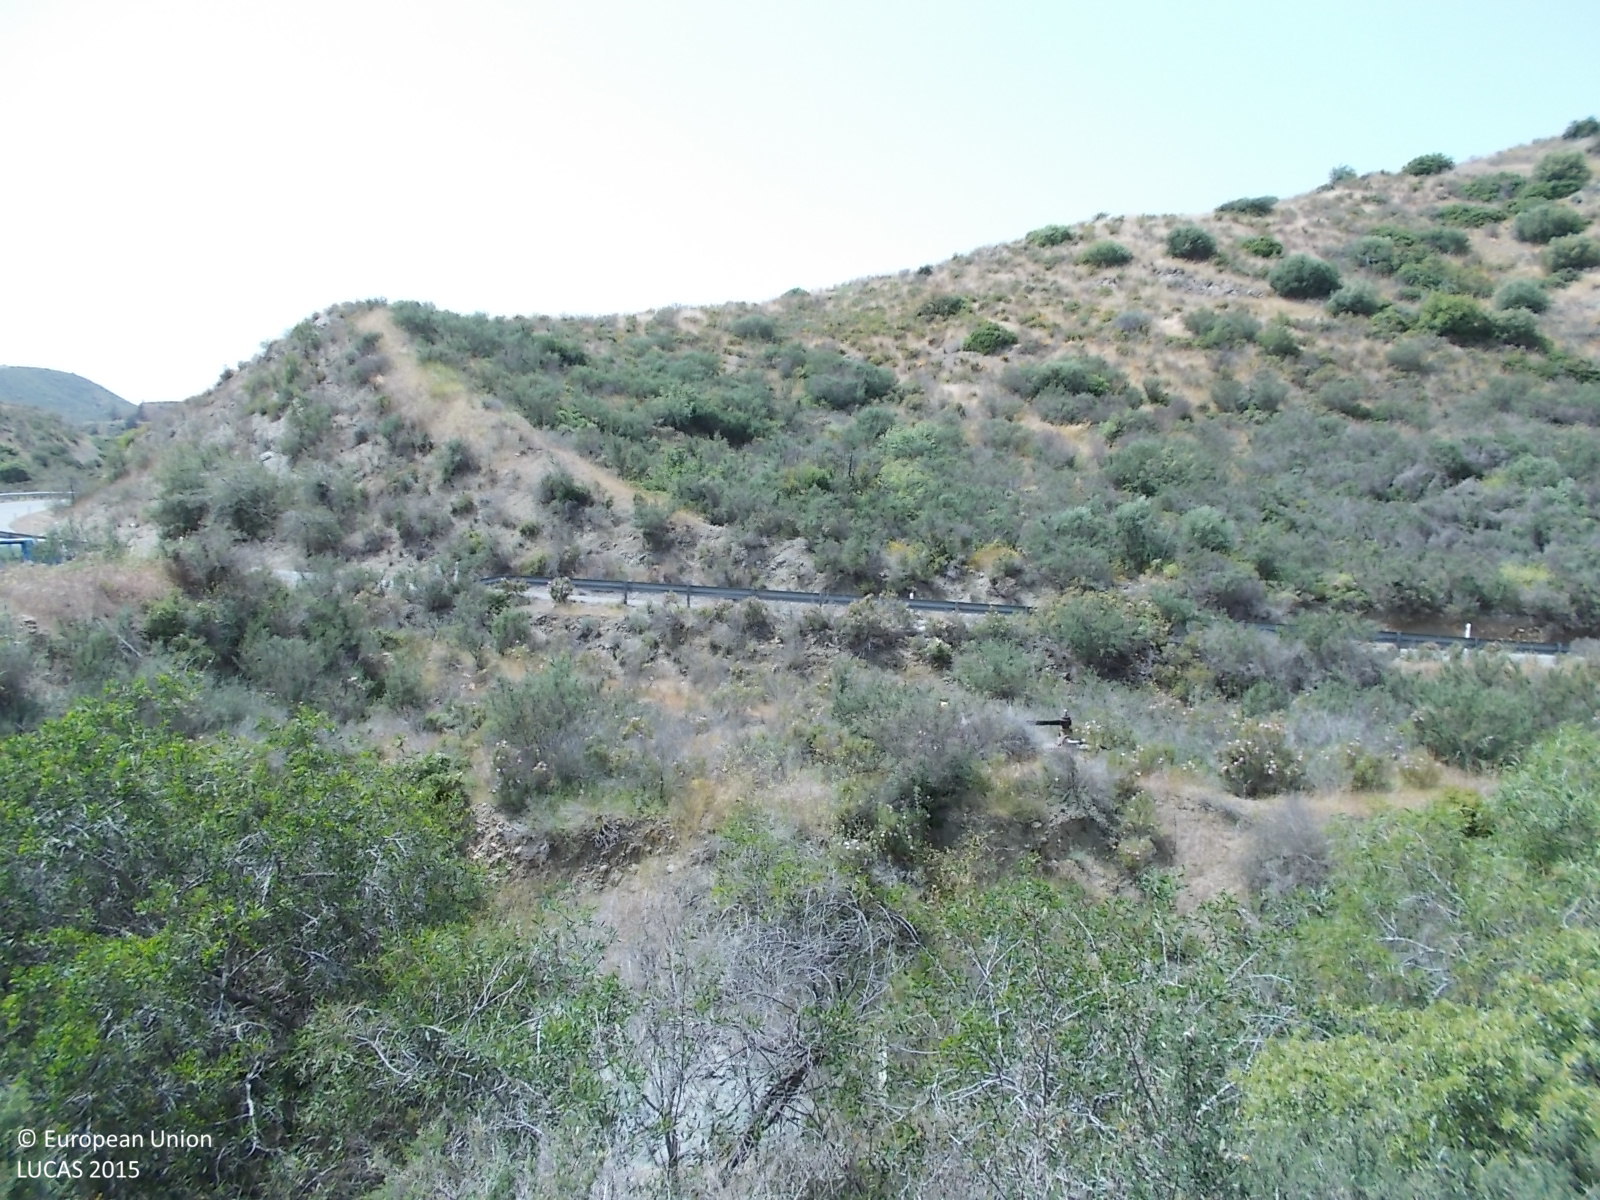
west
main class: Shrubland
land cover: Shrubland without tree cover
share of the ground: > 75 %
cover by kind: shrubs 90 %, herbaceous plants 10 %
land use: Semi-natural and natural areas not in use
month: April
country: CY
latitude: 34.7923
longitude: 33.2254
